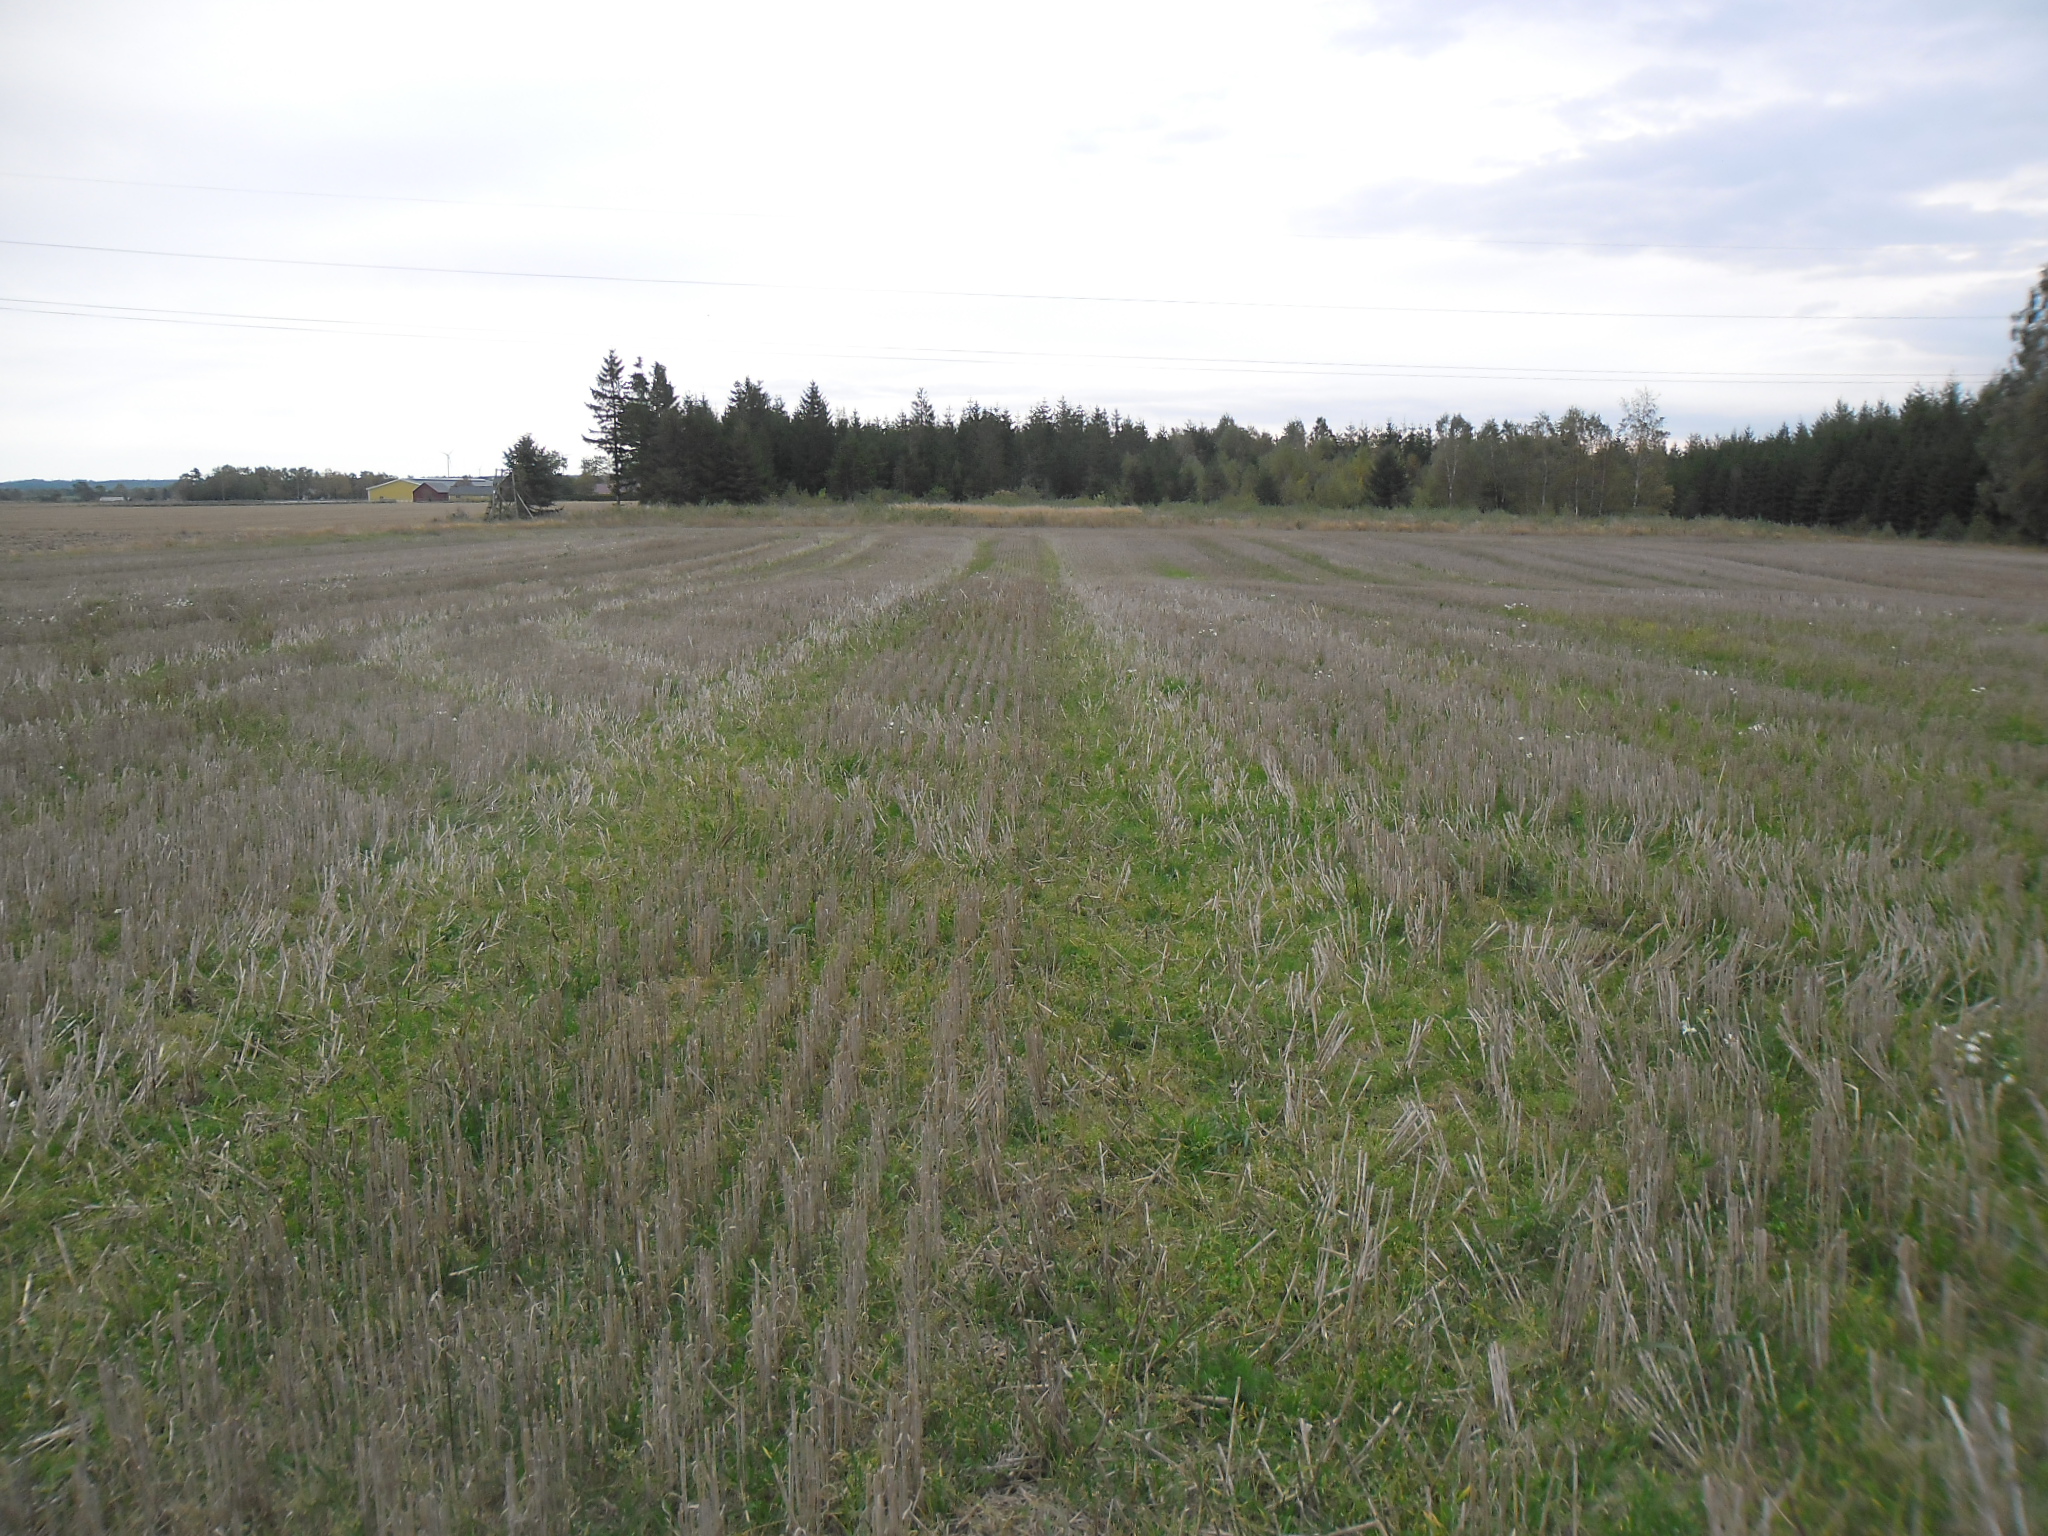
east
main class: Cropland
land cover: Barley
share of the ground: 10 - 25 %
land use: Agriculture (excluding fallow land and kitchen gardens)
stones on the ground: < 10 %
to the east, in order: Barley; Spontaneously vegetated surfaces; Electric lines; Spontaneously vegetated surfaces; Spruce dominated coniferous woodland; Spontaneously vegetated surfaces
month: October
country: SE
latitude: 56.5281
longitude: 13.1021
